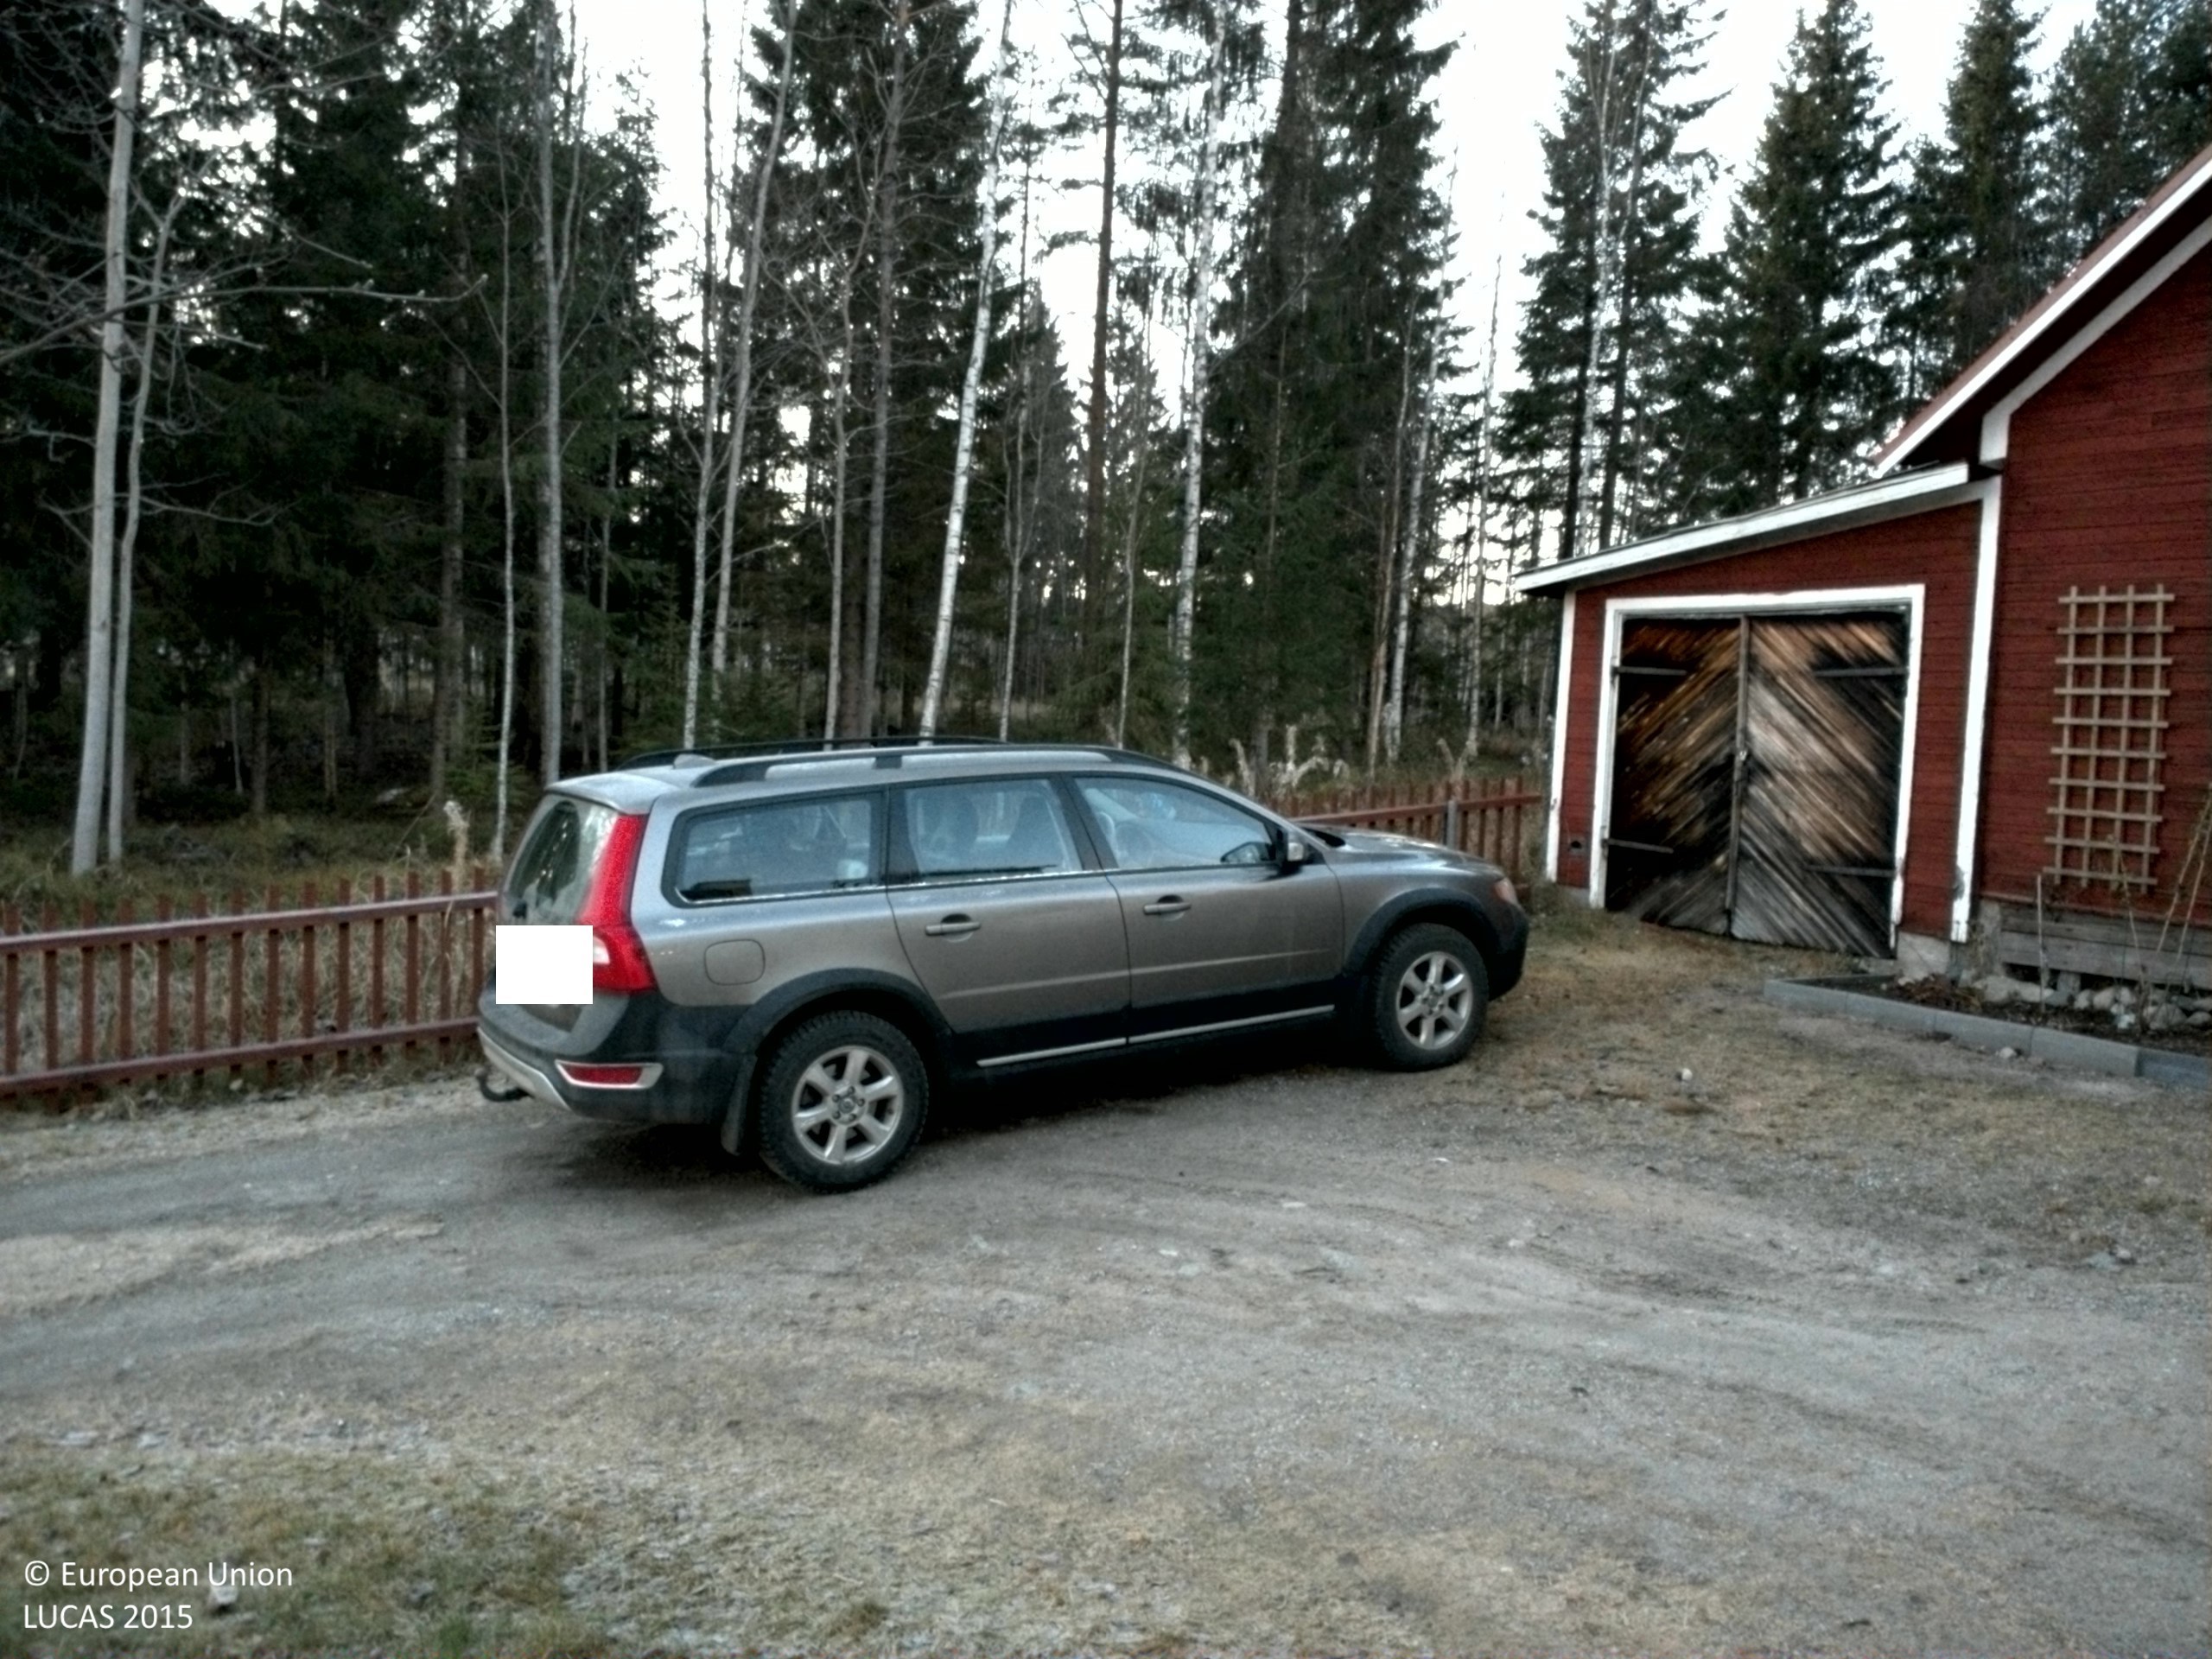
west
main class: Woodland
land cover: Broadleaved woodland
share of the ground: 10 - 25 %
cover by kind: herbaceous plants 85 %, broadleaved forest trees 15 %
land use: Residential
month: November
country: SE
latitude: 61.2630
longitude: 16.8284
